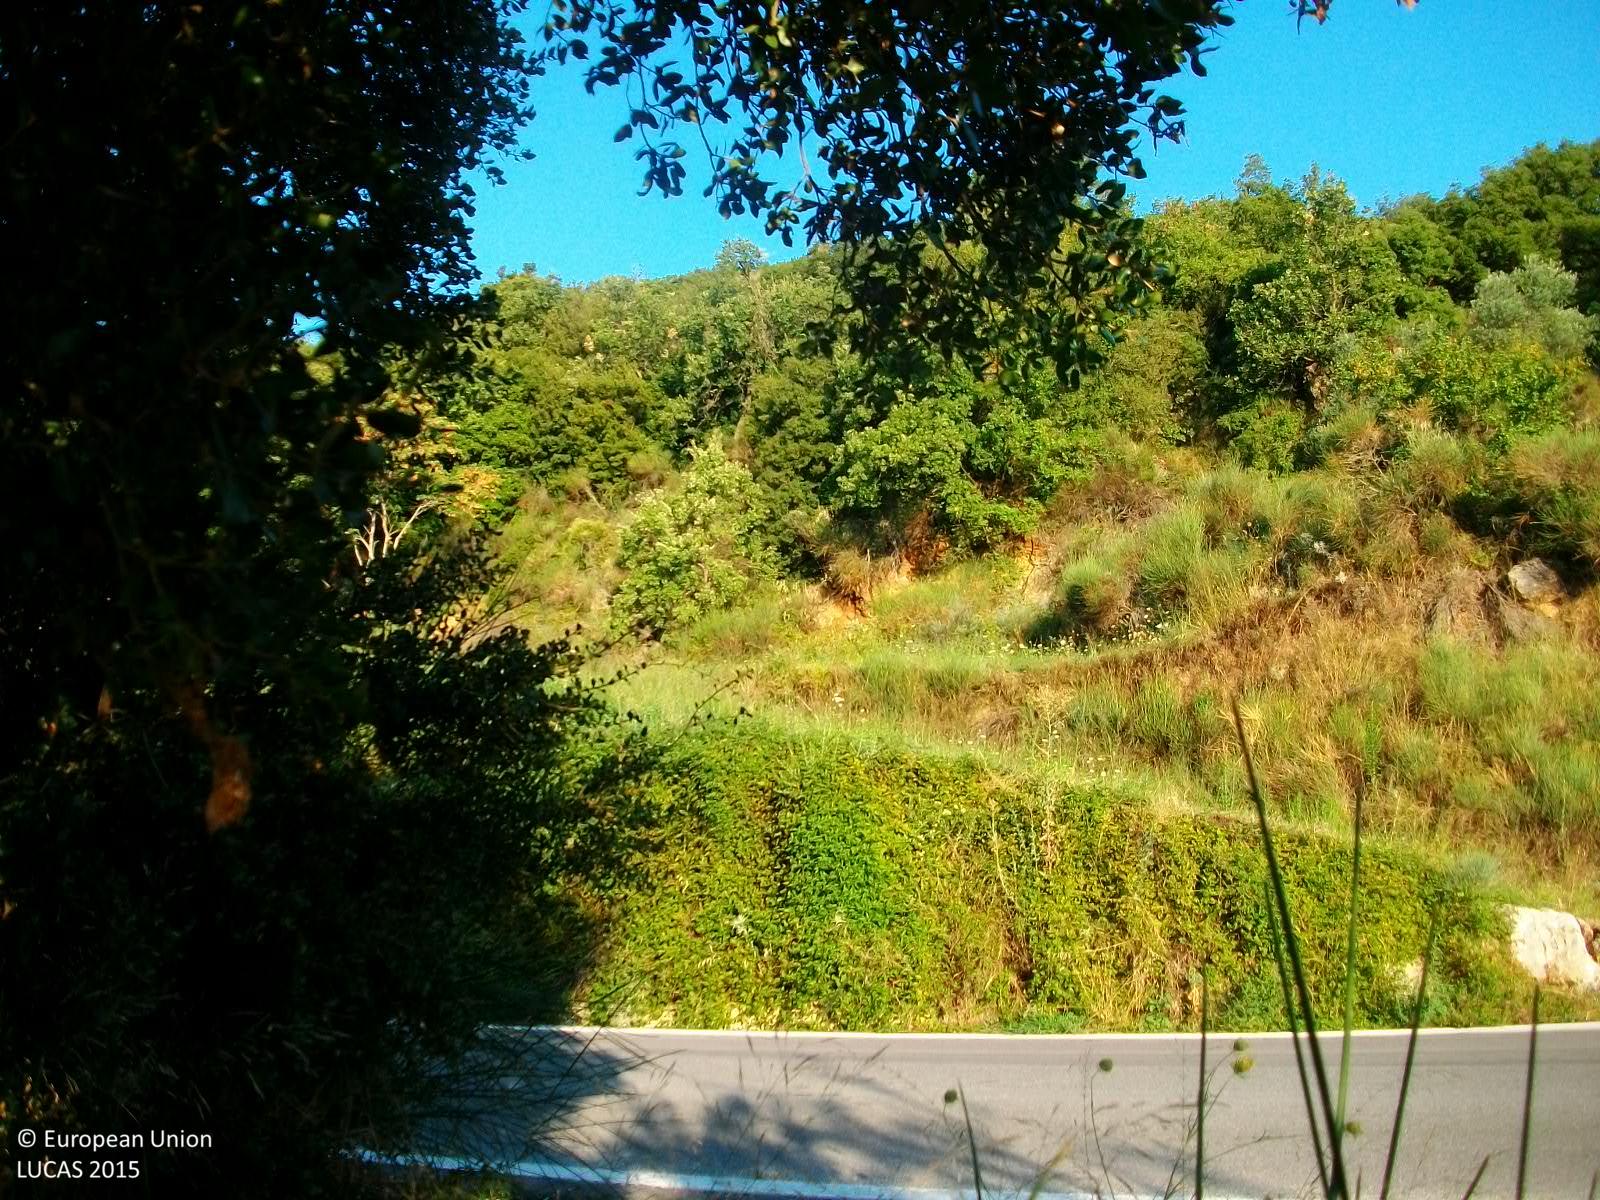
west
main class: Shrubland
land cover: Shrubland without tree cover
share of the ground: > 75 %
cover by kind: shrubs 100 %
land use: Semi-natural and natural areas not in use
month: August
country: GR
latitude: 37.1852
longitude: 22.2912
